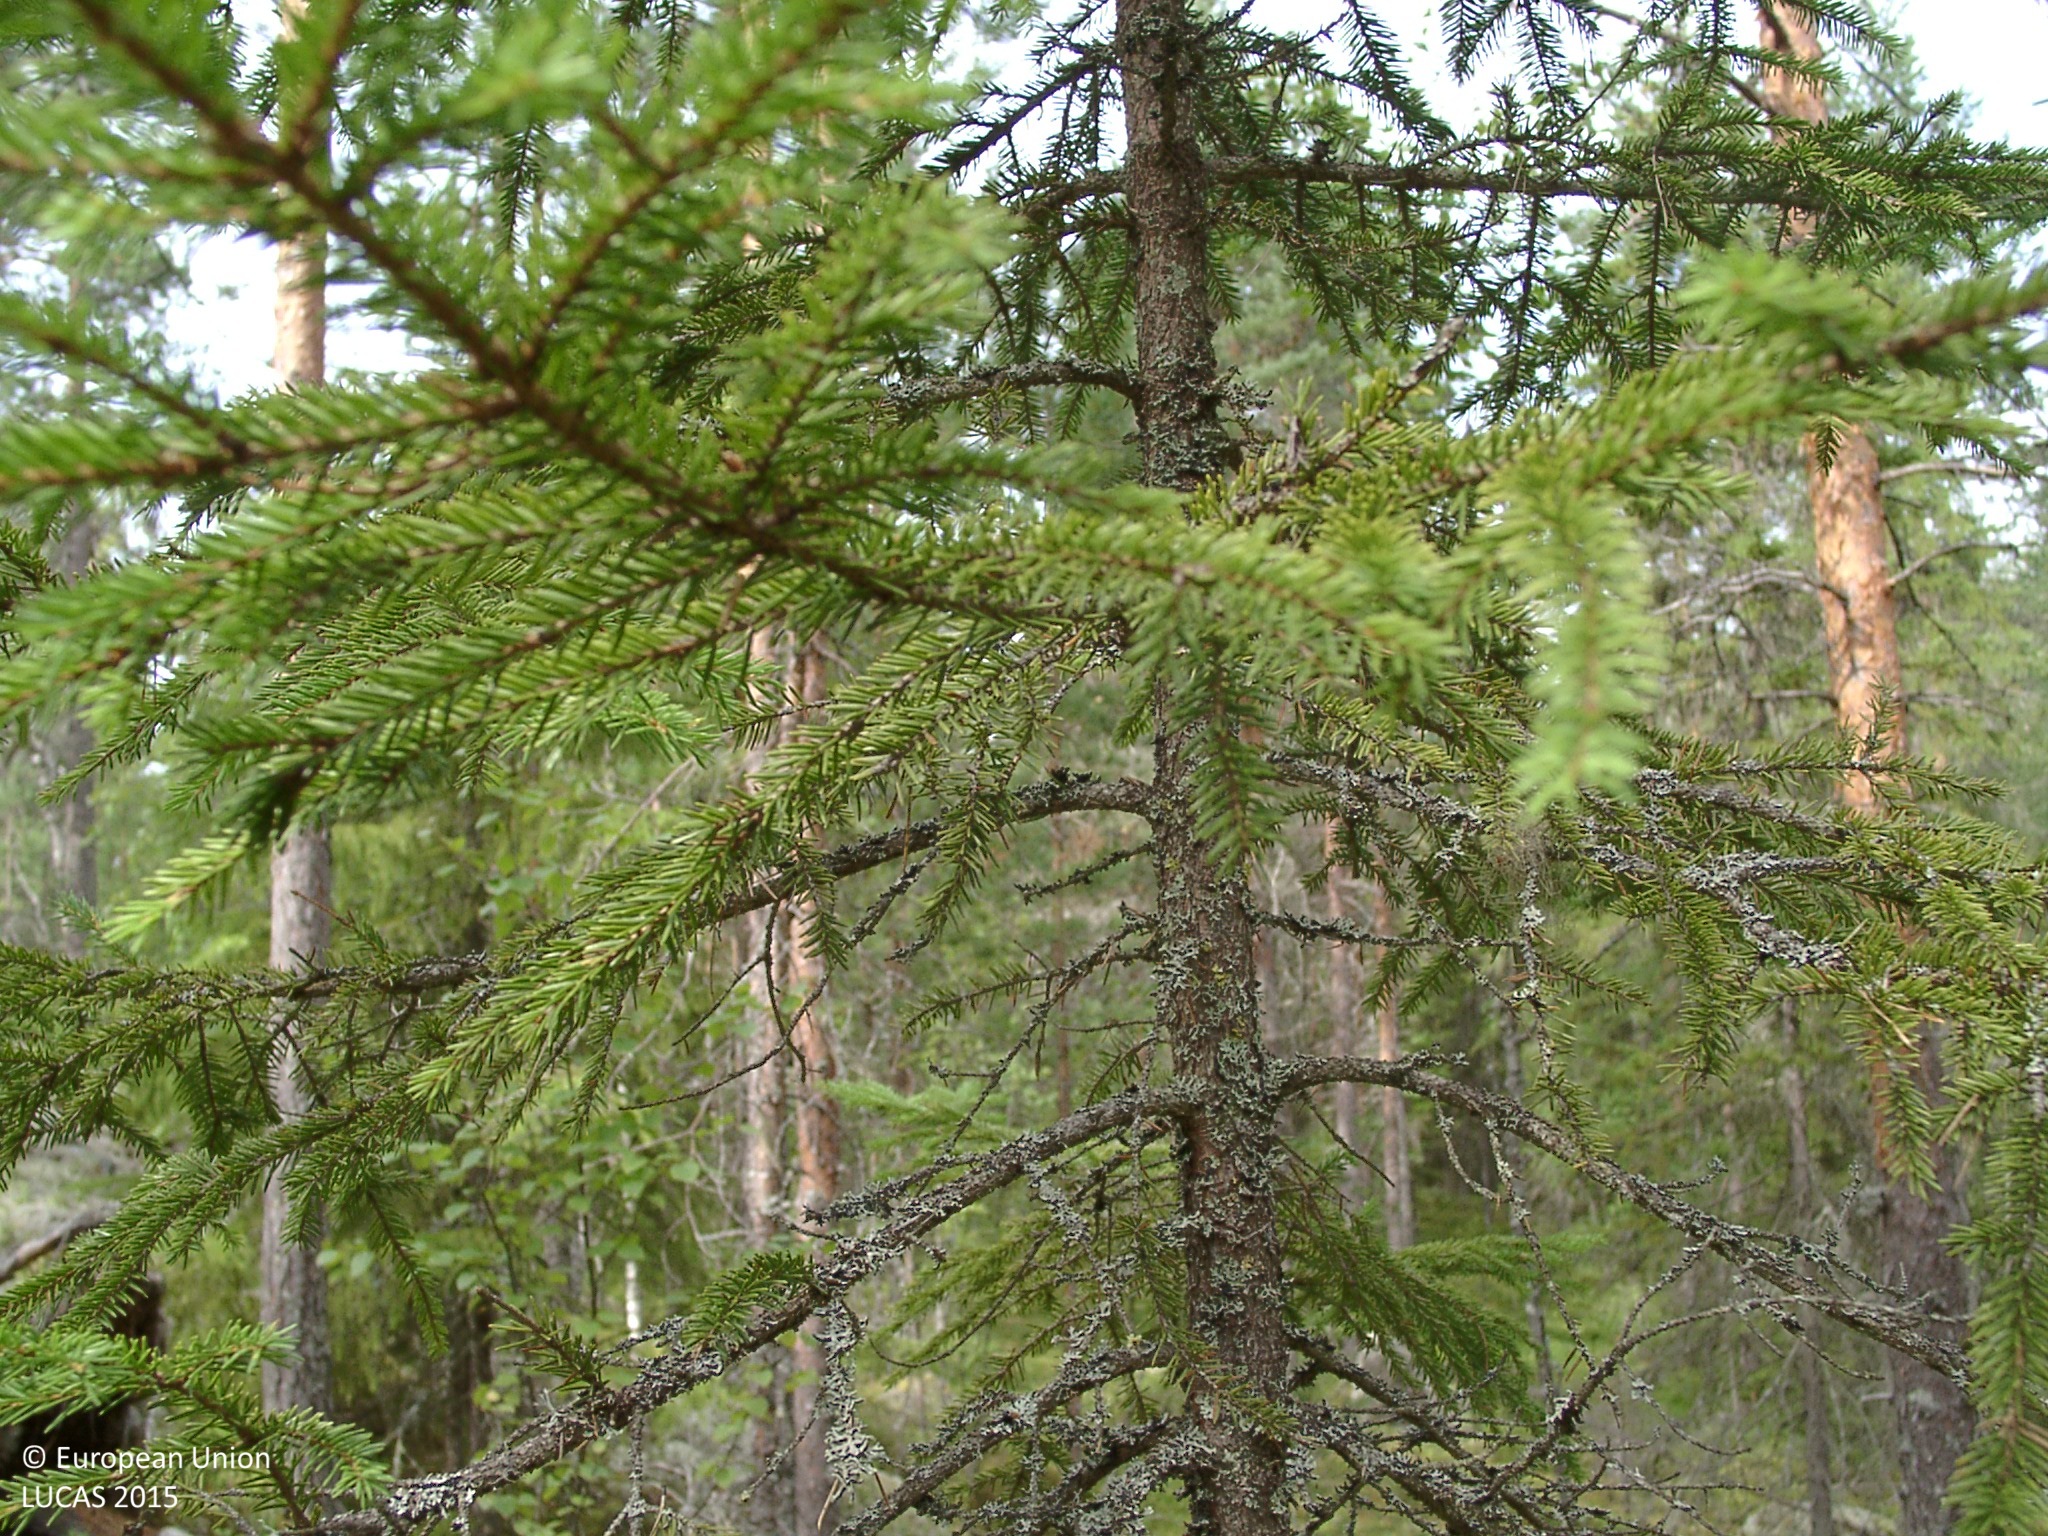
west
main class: Woodland
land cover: Other mixed woodland
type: boreal forest
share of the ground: 50 - 75 %
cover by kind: coniferous forest trees 40 %, lichens and mosses 25 %, shrubs 20 %, broadleaved forest trees 15 %
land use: Forestry
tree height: > 5 m
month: August
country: FI
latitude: 61.8604
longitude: 25.2996
